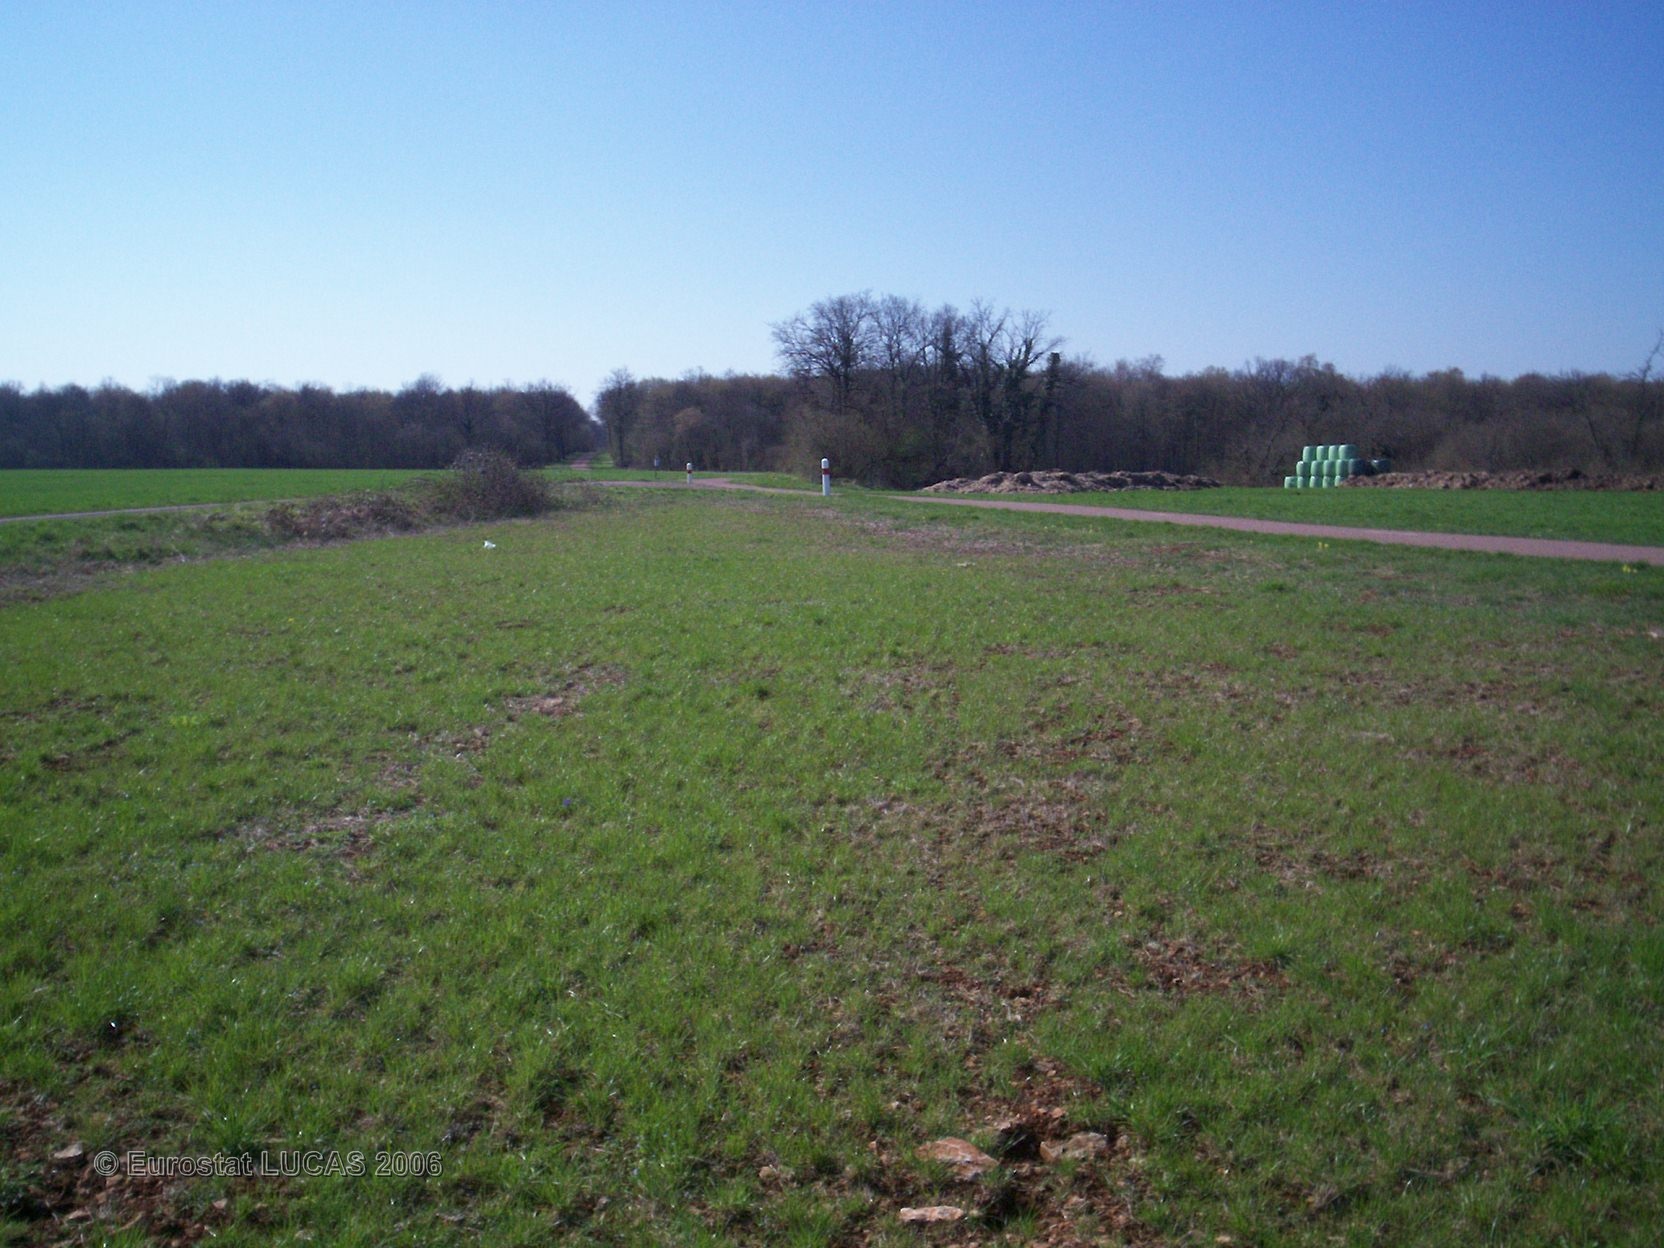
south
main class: Grassland
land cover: Grassland without tree/shrub cover
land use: Fallow land
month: April
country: FR
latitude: 47.4228
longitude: 4.5778
